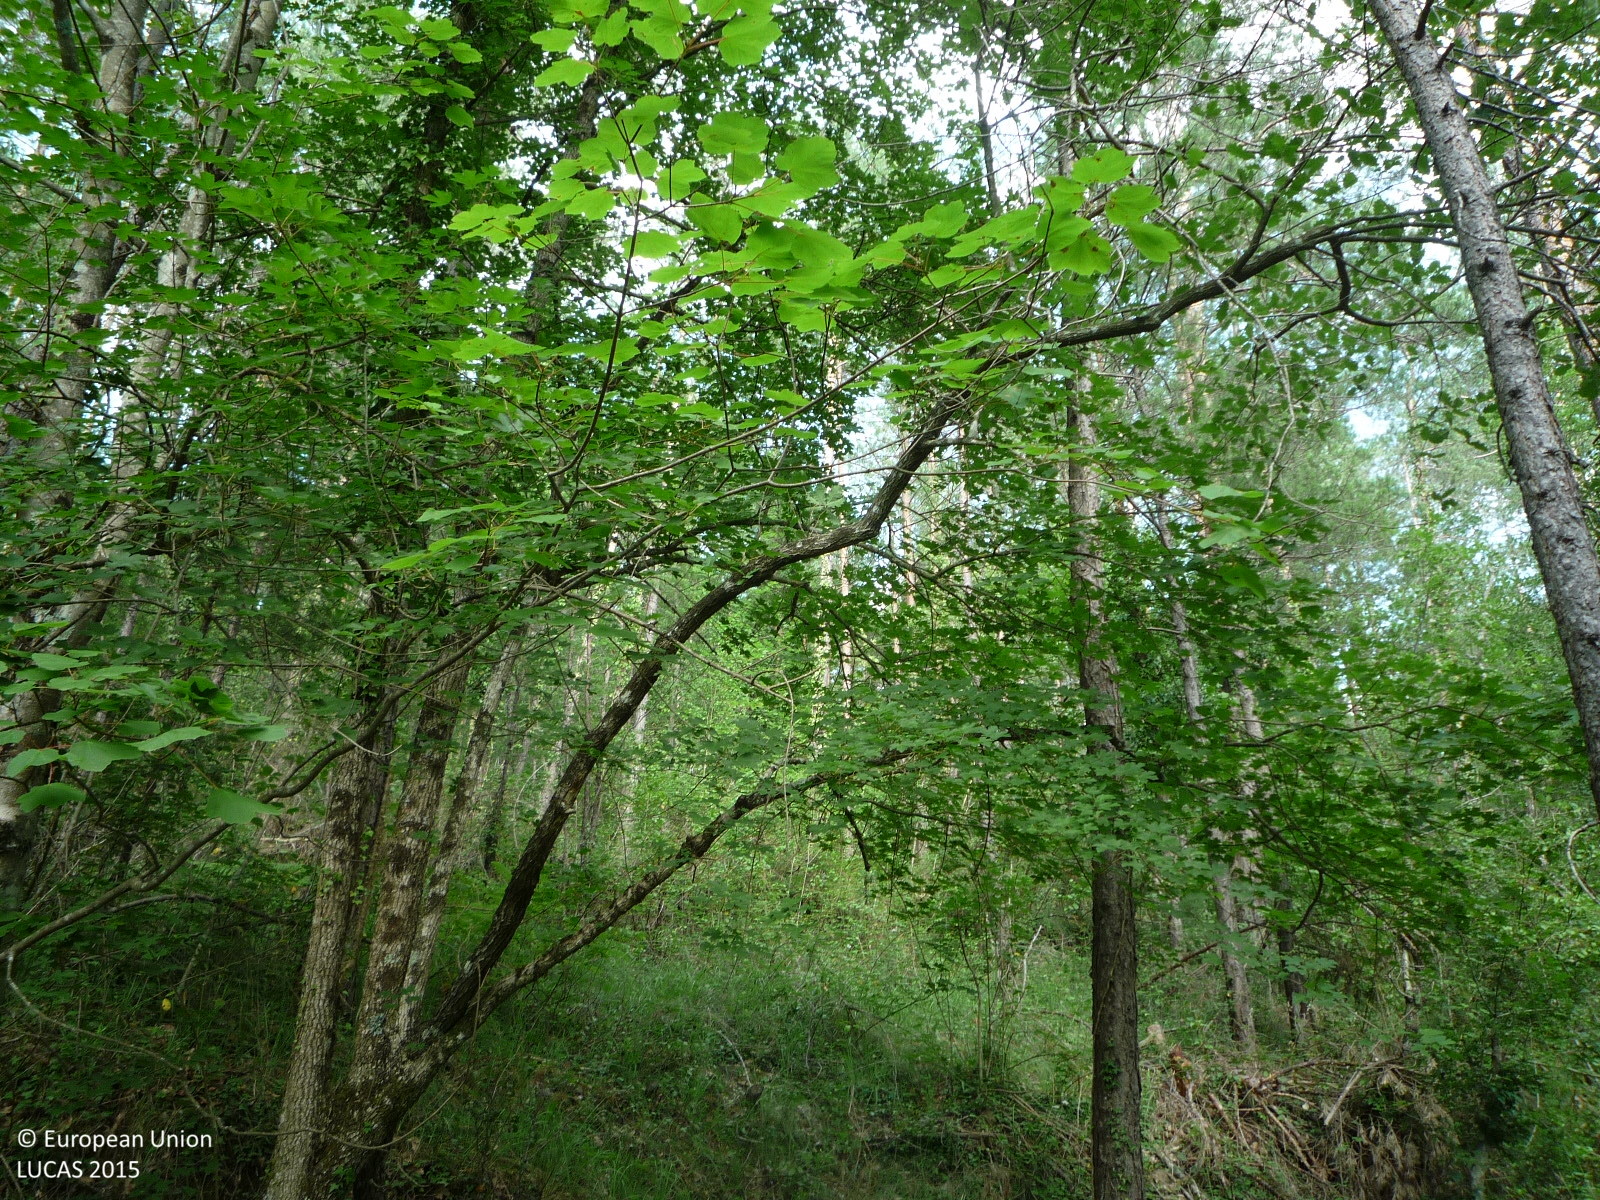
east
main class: Woodland
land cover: Pine dominated mixed woodland
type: coniferous forest of the mediterranean region
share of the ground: > 75 %
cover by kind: coniferous forest trees 60 %, broadleaved forest trees 30 %, herbaceous plants 10 %
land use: Forestry
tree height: > 5 m
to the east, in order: Pine dominated mixed woodland; Tracks; Pine dominated coniferous woodland; Dry stone walls; Pine dominated coniferous woodland; Tracks; Fences; Pine dominated coniferous woodland; Pine dominated mixed woodland
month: June
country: ES
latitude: 42.1350
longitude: 1.9676
